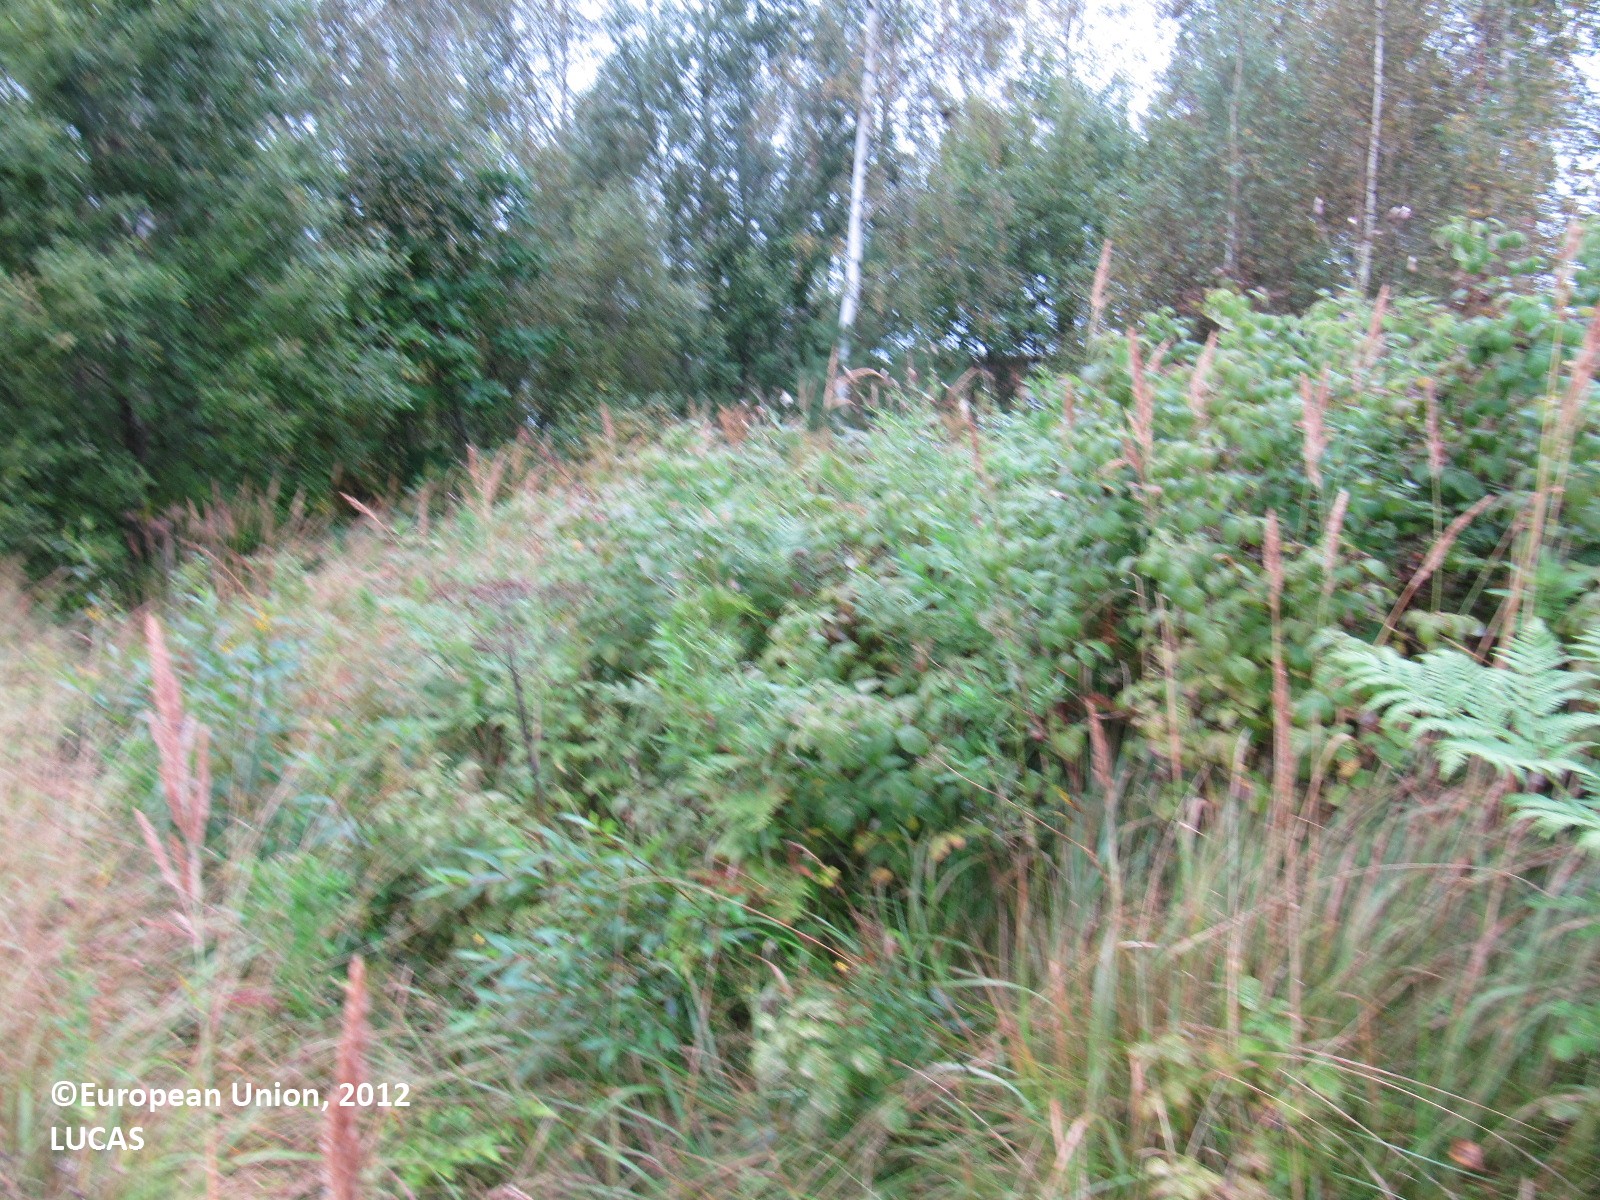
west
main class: Cropland
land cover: Barley
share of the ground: > 75 %
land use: Agriculture (excluding fallow land and kitchen gardens)
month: September
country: FI
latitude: 60.0583
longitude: 24.0566
